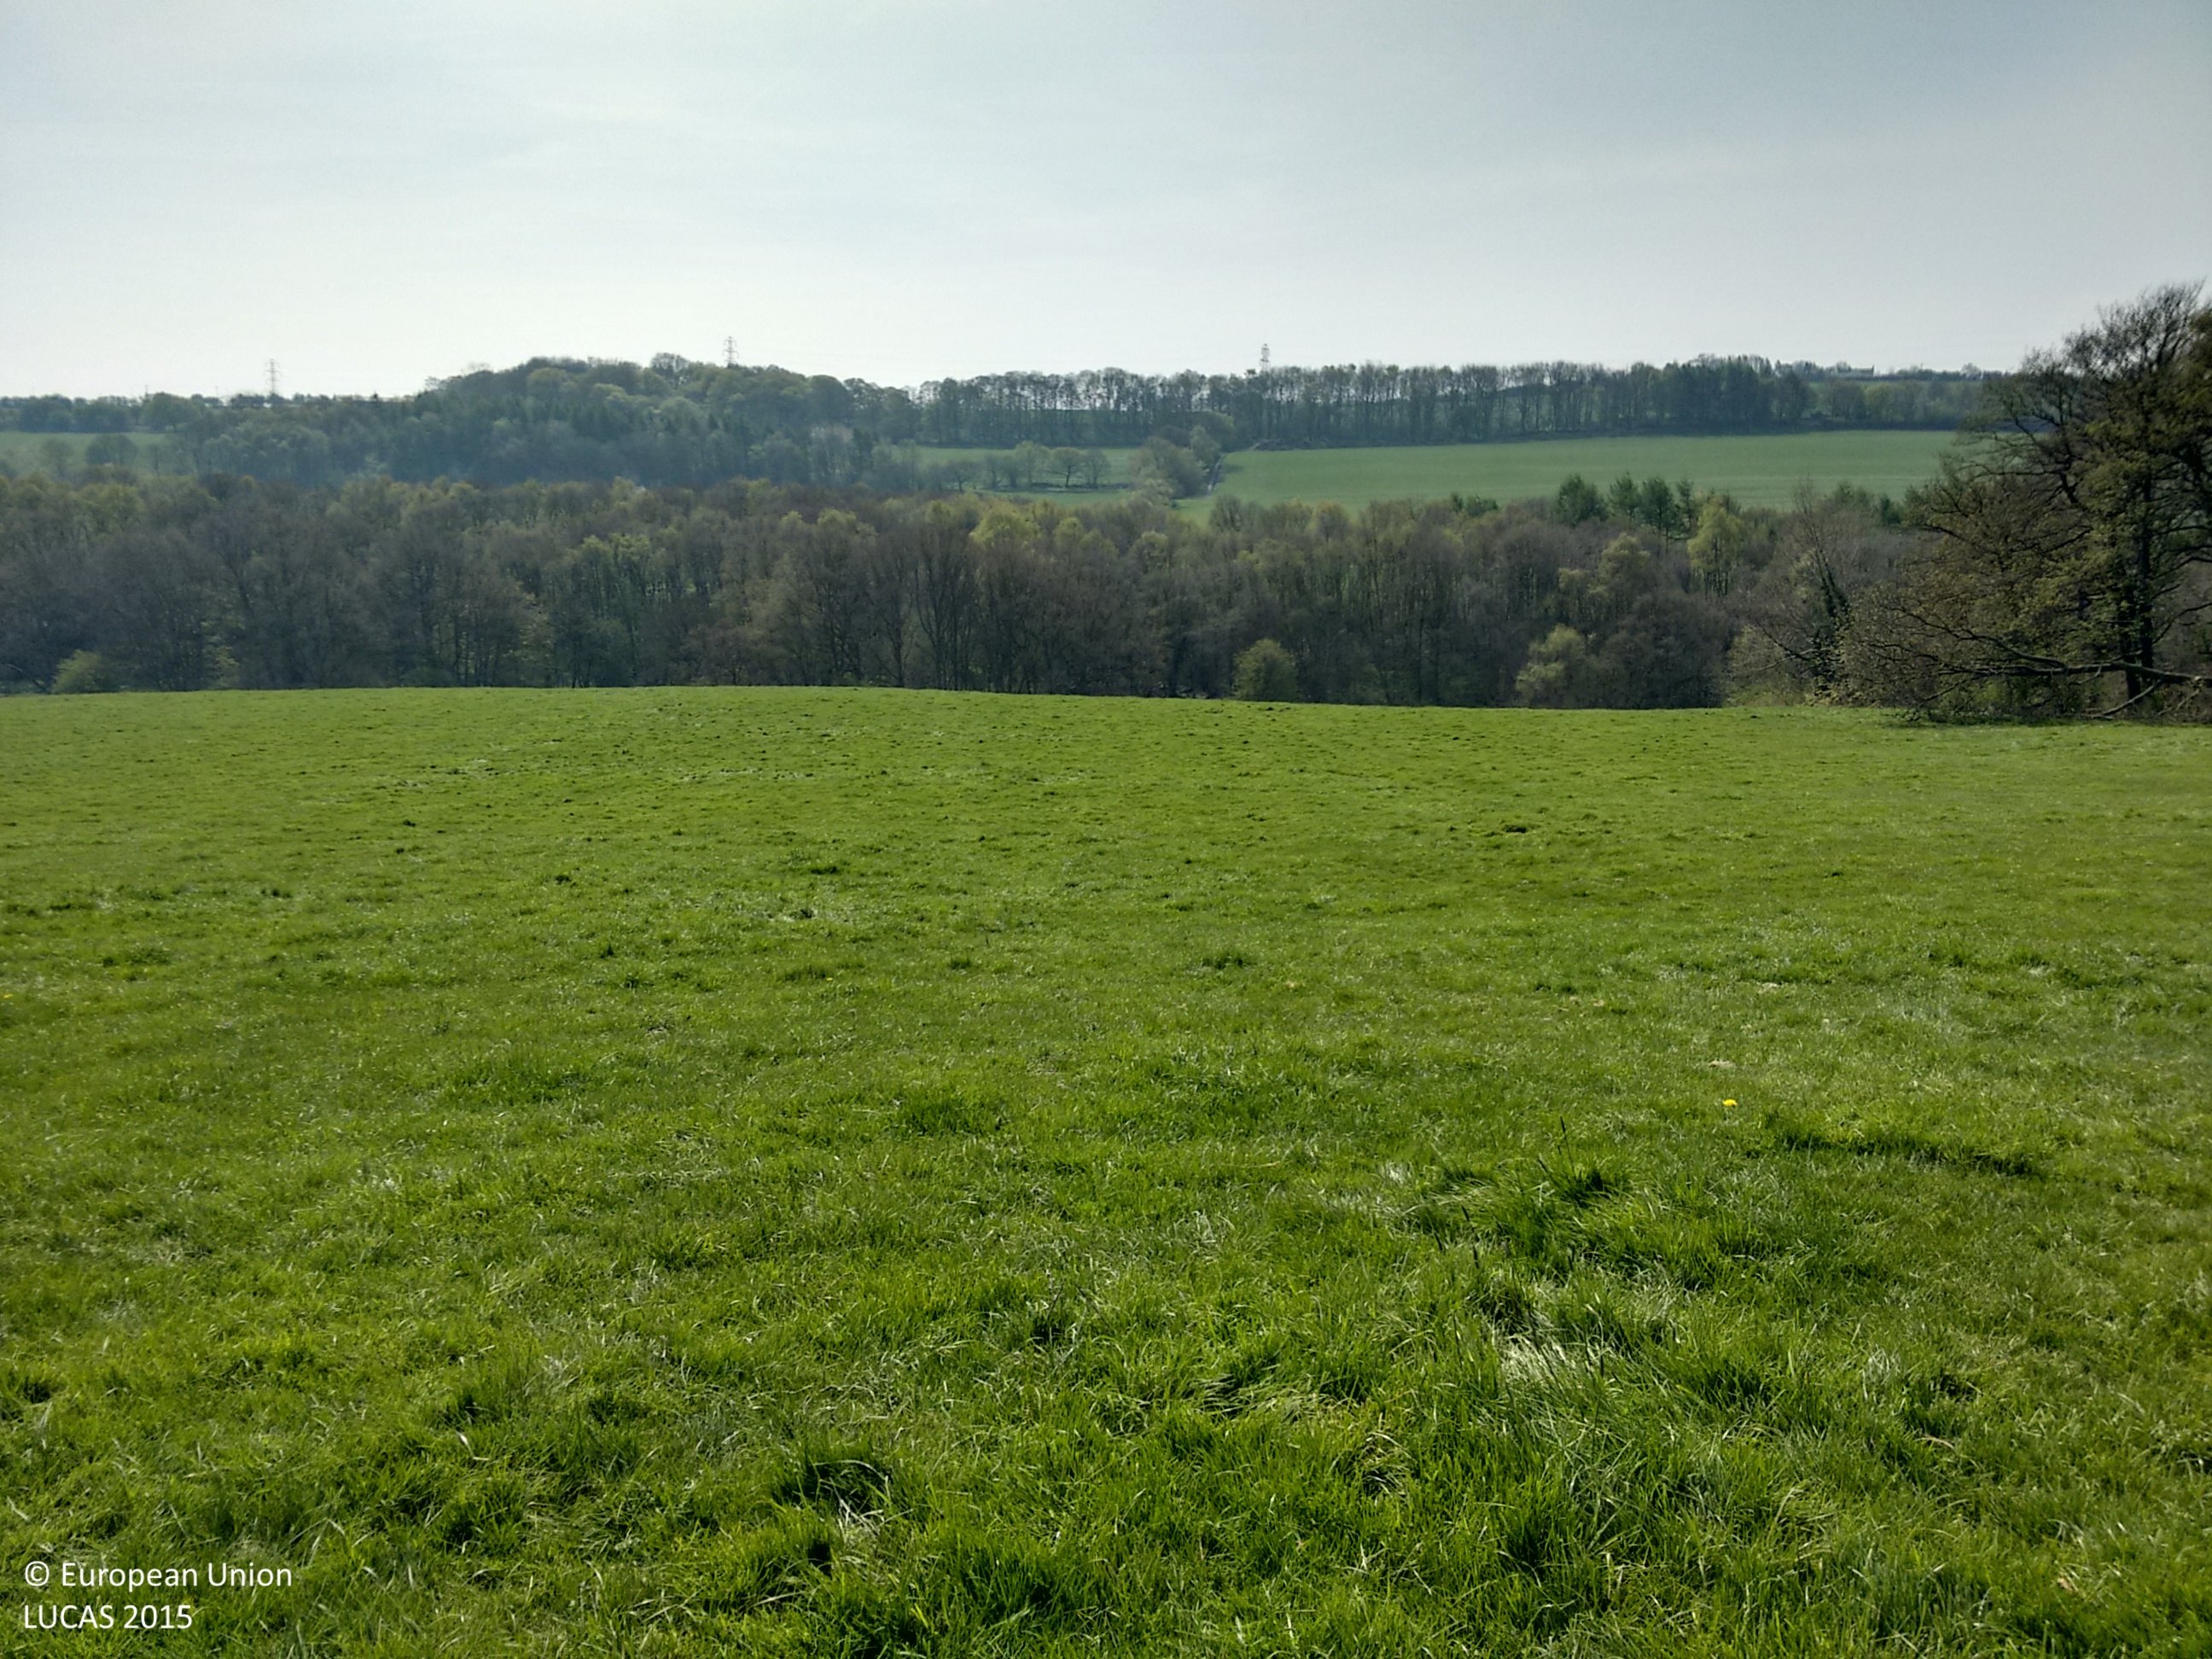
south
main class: Grassland
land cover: Grassland without tree/shrub cover
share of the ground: > 75 %
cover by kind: herbaceous plants 100 %
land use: Agriculture (excluding fallow land and kitchen gardens)
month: April
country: GB
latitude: 53.7813
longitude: -1.6618
